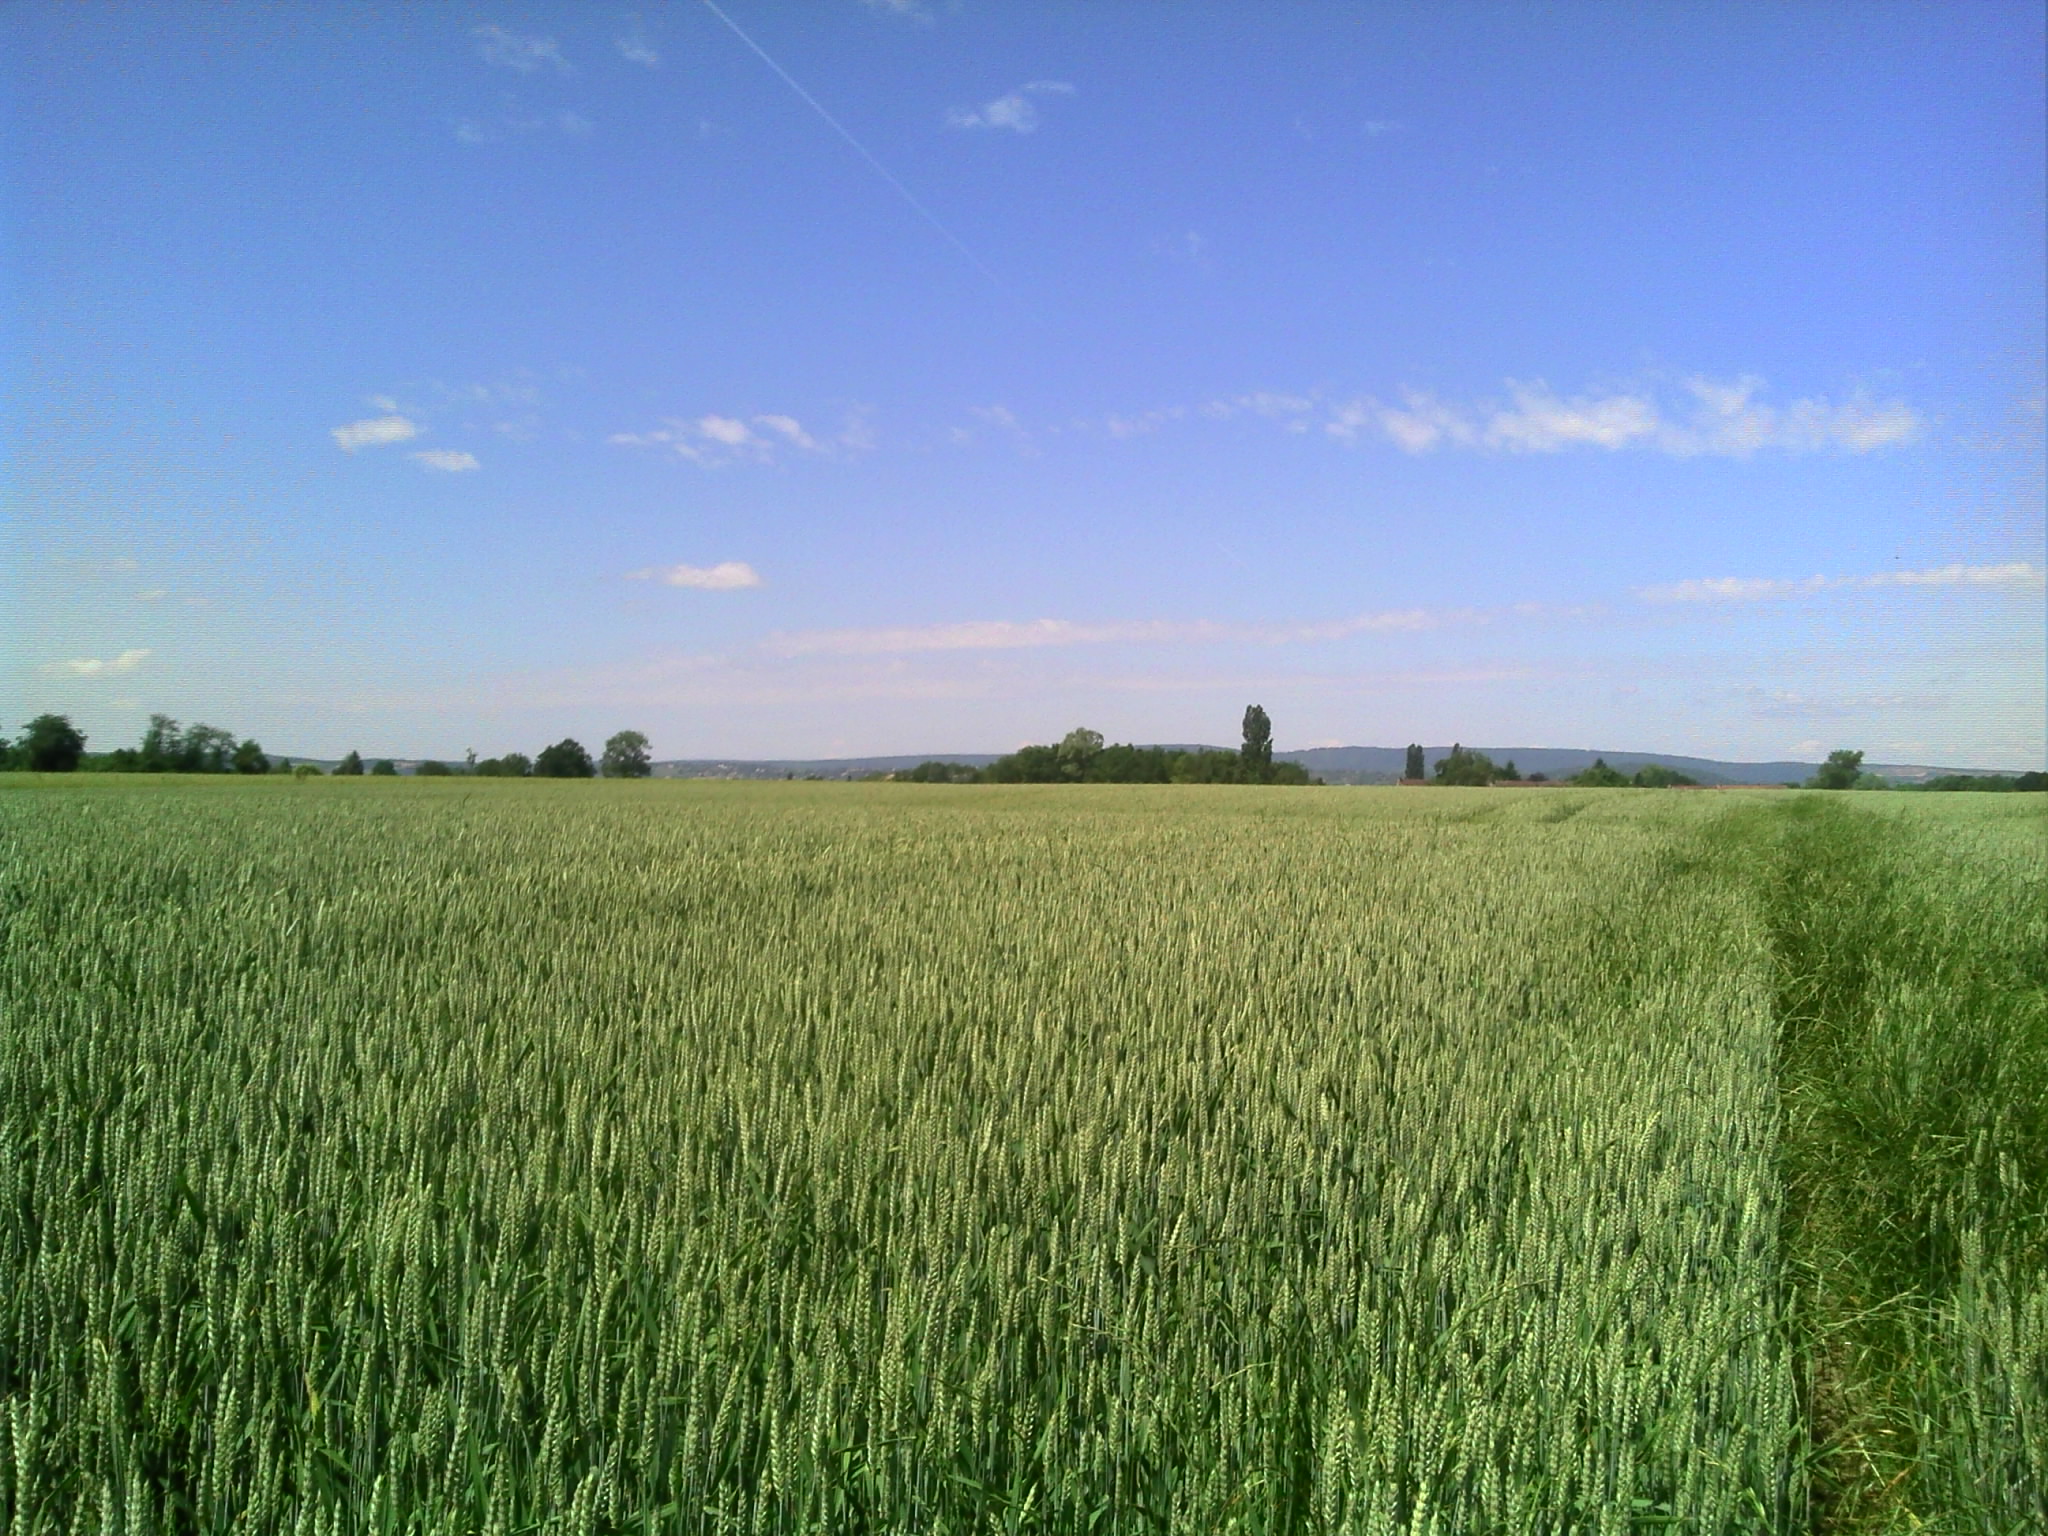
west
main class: Cropland
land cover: Common wheat
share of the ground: > 75 %
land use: Agriculture (excluding fallow land and kitchen gardens)
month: May
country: FR
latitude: 46.5761
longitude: 4.9783
